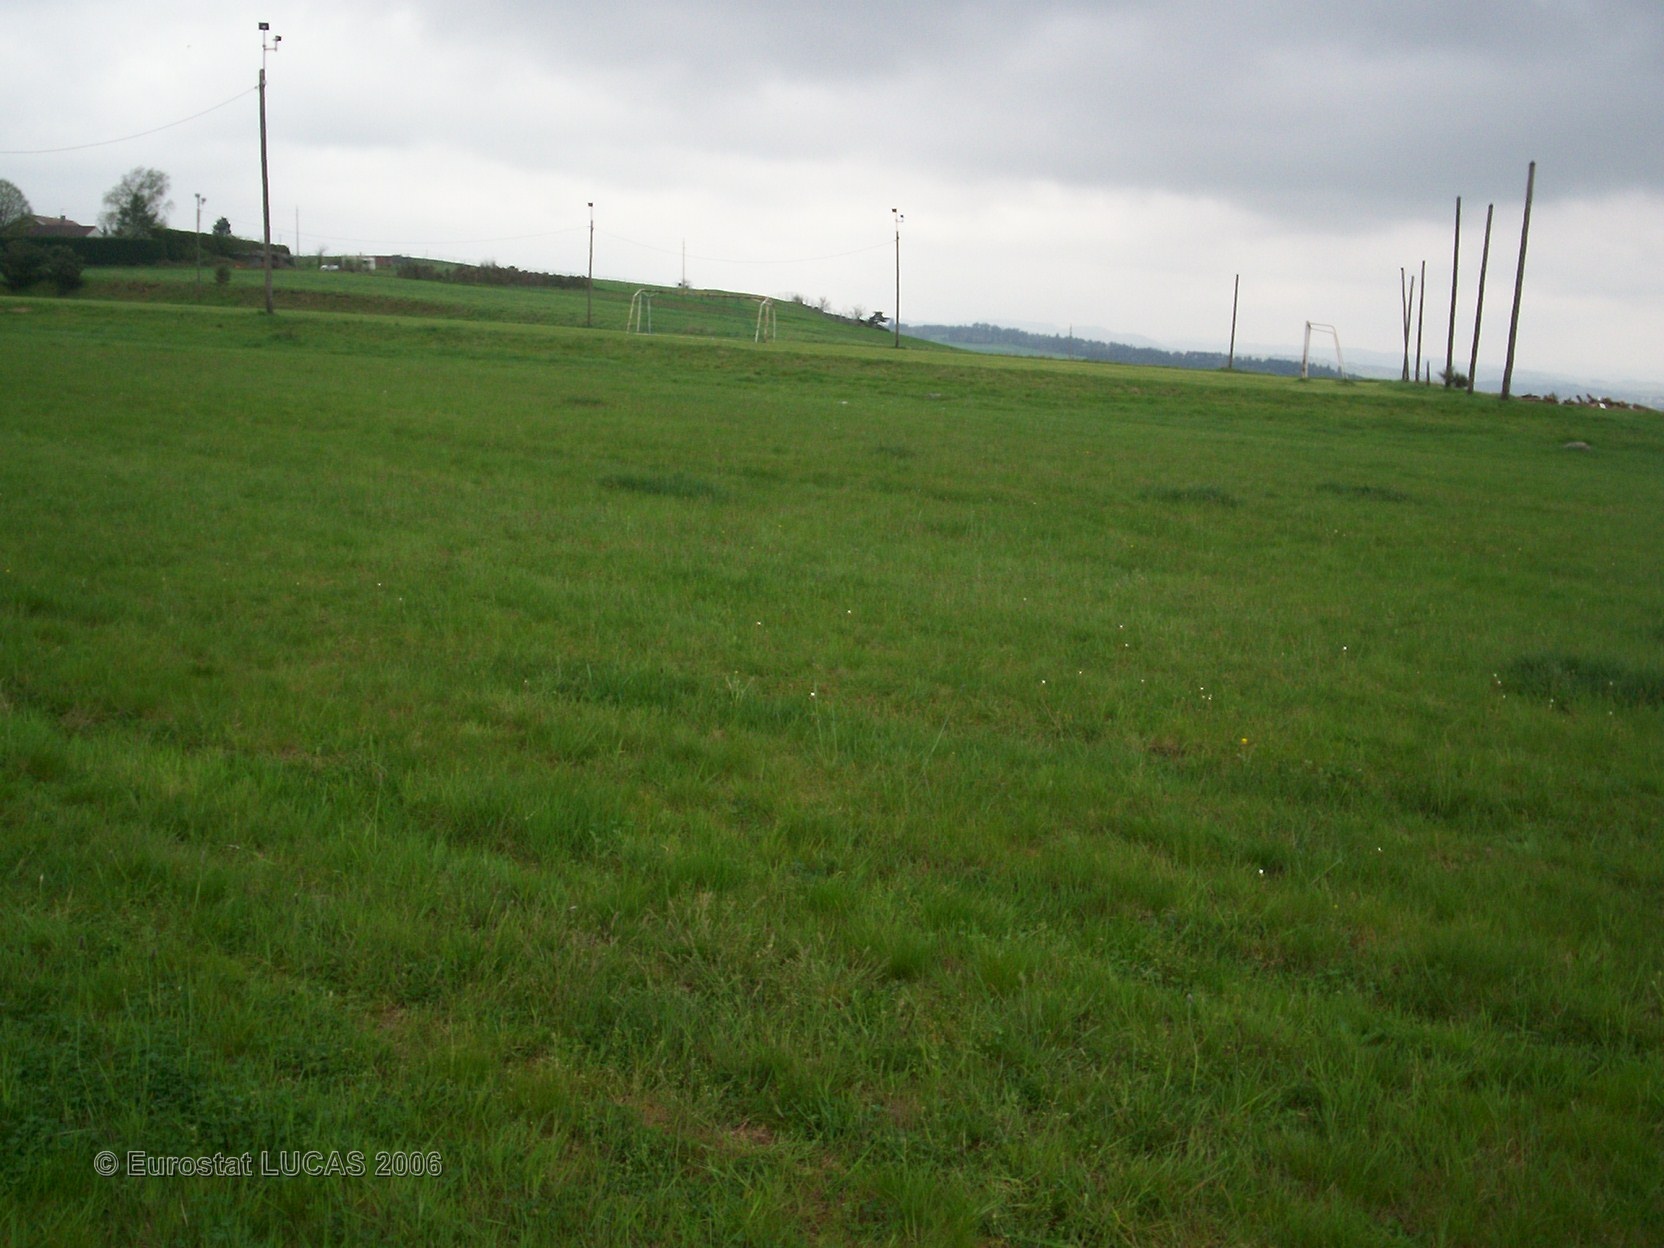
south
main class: Cropland
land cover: Rye
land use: Agriculture (excluding fallow land and kitchen gardens)
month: April
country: FR
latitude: 45.3434
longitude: 4.1714
